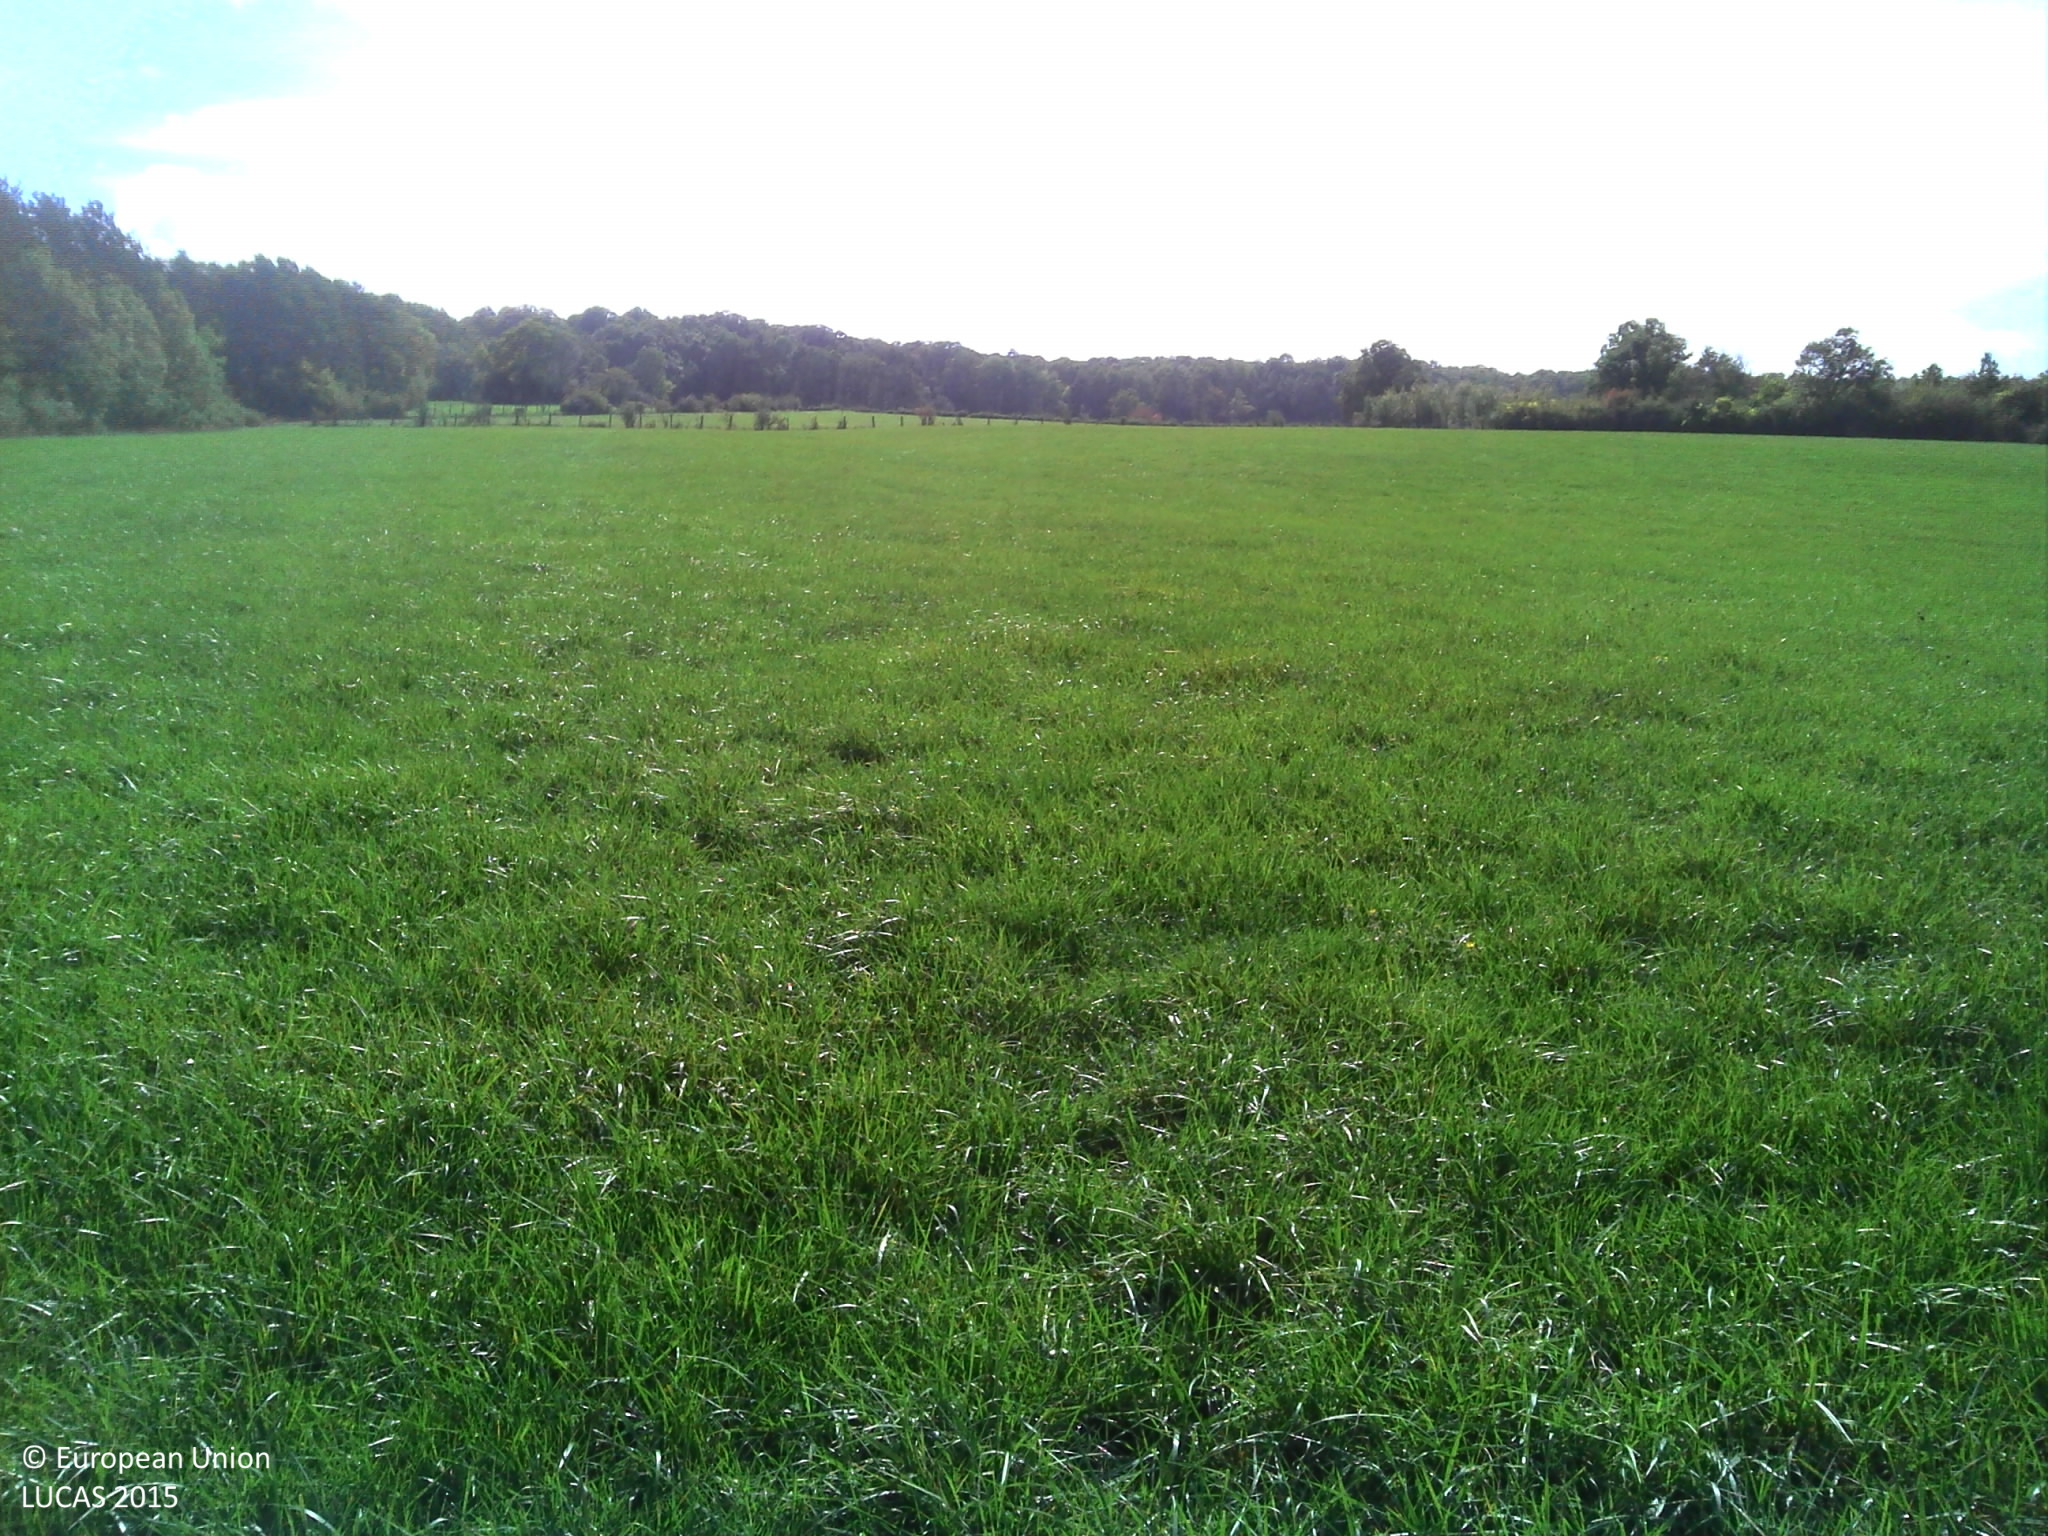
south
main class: Grassland
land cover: Grassland without tree/shrub cover
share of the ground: > 75 %
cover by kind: herbaceous plants 100 %
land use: Agriculture (excluding fallow land and kitchen gardens)
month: October
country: FR
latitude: 48.1889
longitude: 4.3881
